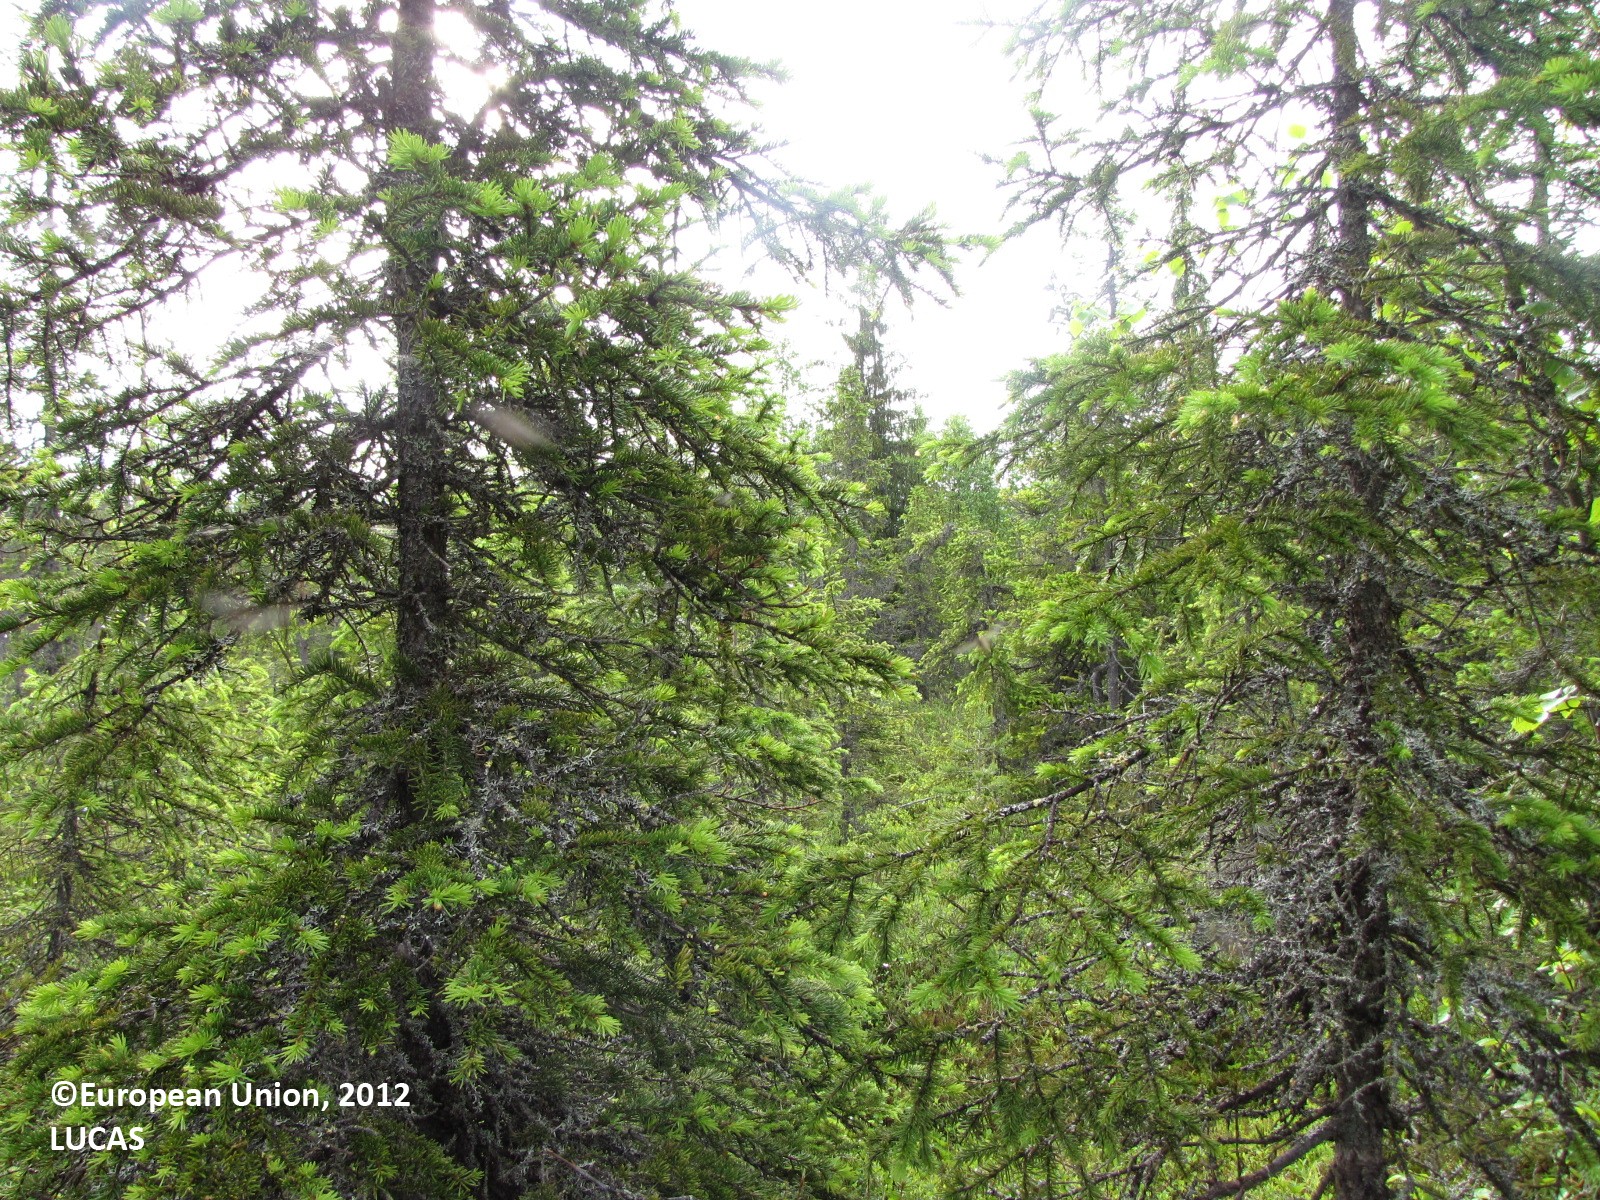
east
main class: Woodland
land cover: Spruce dominated mixed woodland
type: boreal forest
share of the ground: 50 - 75 %
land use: Forestry
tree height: > 5 m
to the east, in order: Spruce dominated mixed woodland; Ditches and canals; Pine dominated mixed woodland; Pine dominated coniferous woodland; Ditches and canals; Spruce dominated mixed woodland; Ditches and canals; Spruce dominated mixed woodland; Ditches and canals; Spruce dominated mixed woodland
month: June
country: FI
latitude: 66.2158
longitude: 24.7409
